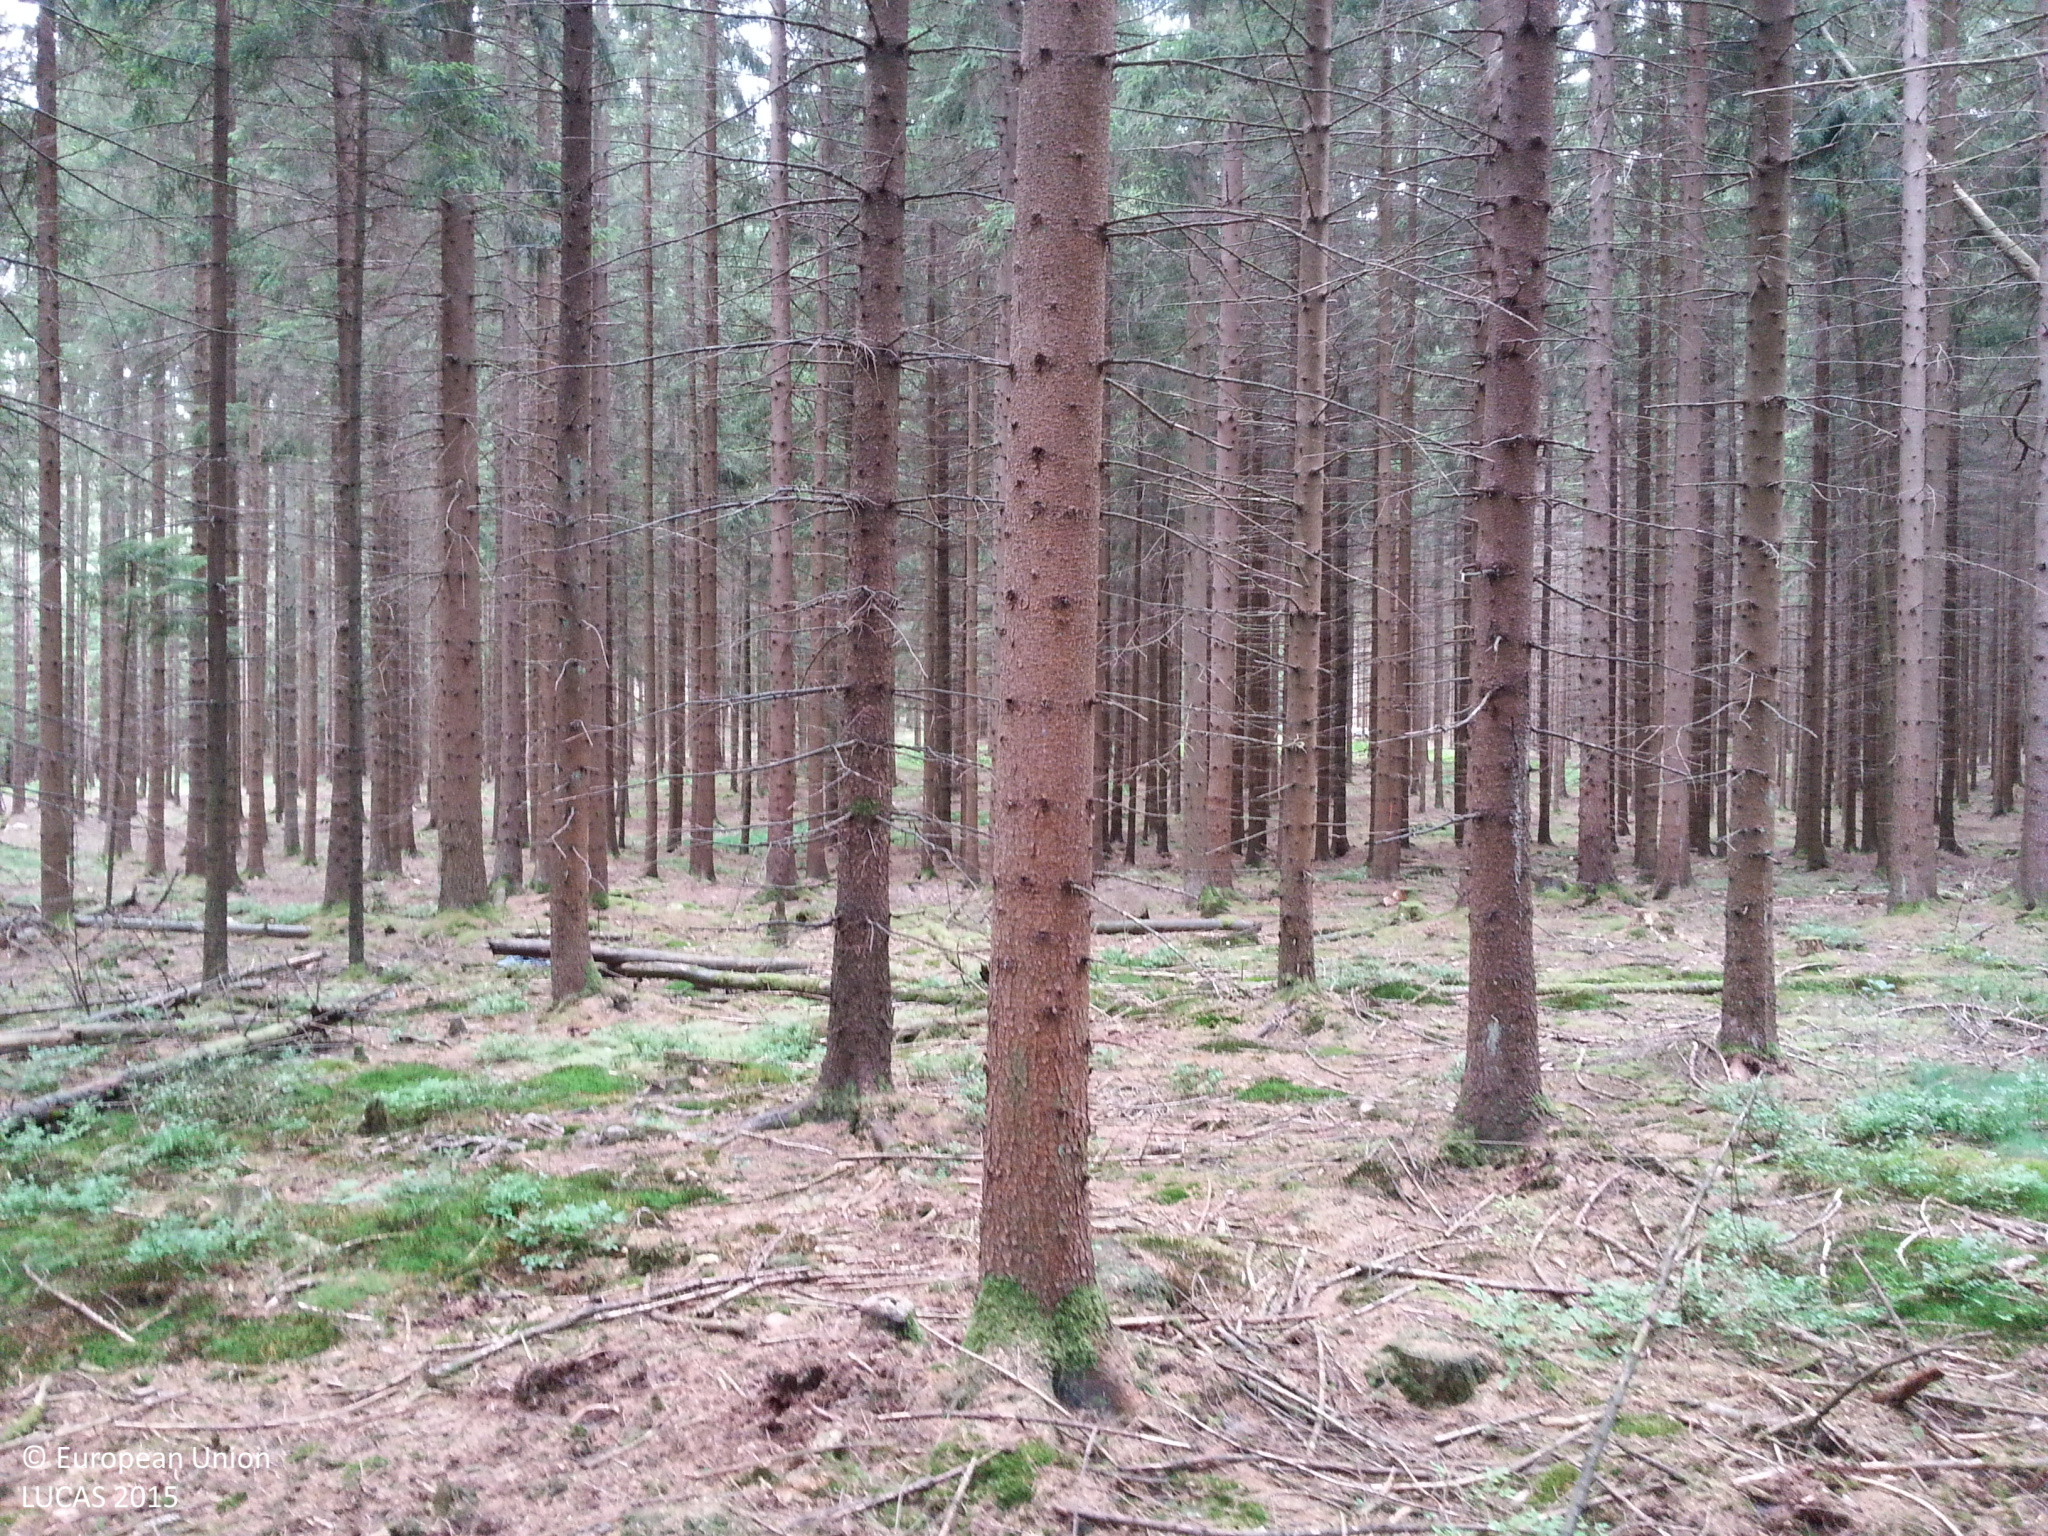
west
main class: Woodland
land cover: Spruce dominated coniferous woodland
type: boreal forest
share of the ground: > 75 %
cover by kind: coniferous forest trees 85 %, herbaceous plants 10 %, lichens and mosses 5 %
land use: Forestry
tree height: > 5 m
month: September
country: DE
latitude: 49.4979
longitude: 9.1857
